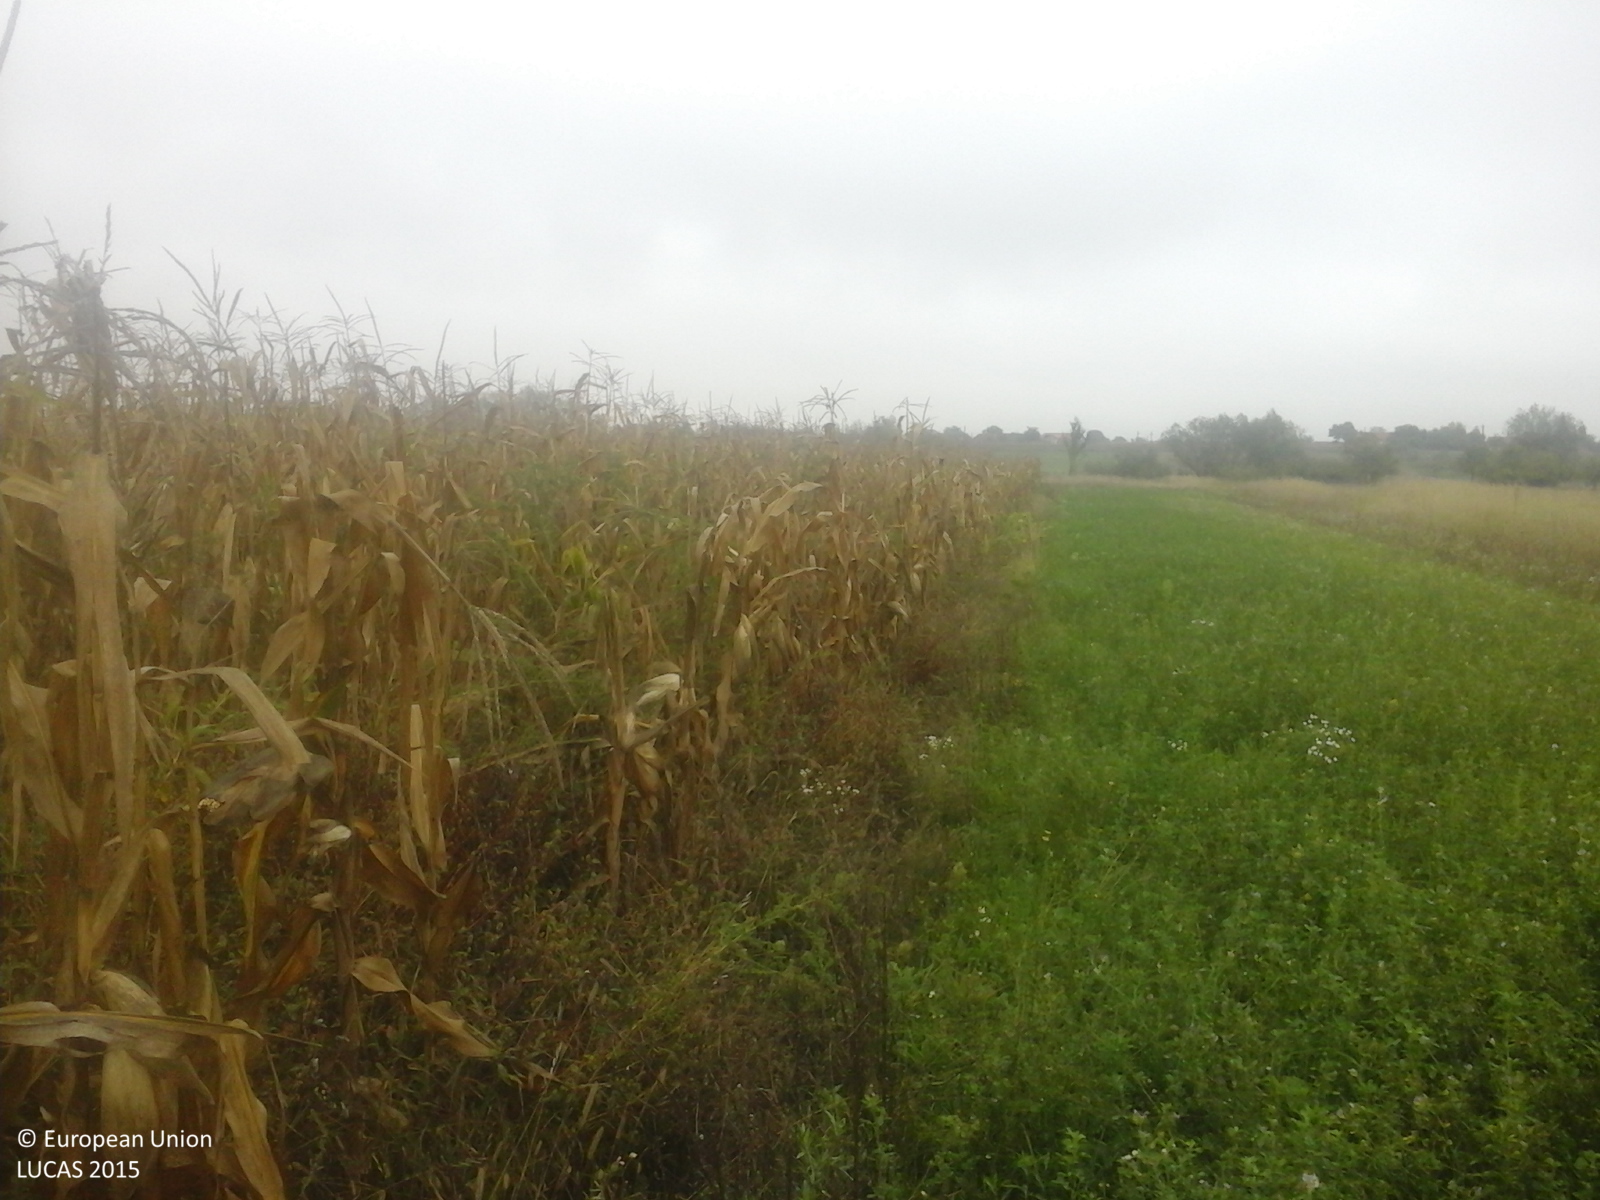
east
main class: Cropland
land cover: Maize
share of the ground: > 75 %
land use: Agriculture (excluding fallow land and kitchen gardens)
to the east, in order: Maize; Grass margins; Maize; Common wheat; Tracks; Spontaneously vegetated surfaces; Potatoes; Grassland without tree/shrub cover; Single bushes/trees; Ditches and canals; Shruby margins; Lucerne; Abandoned hedges
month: September
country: RO
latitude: 45.8250
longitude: 22.1028
